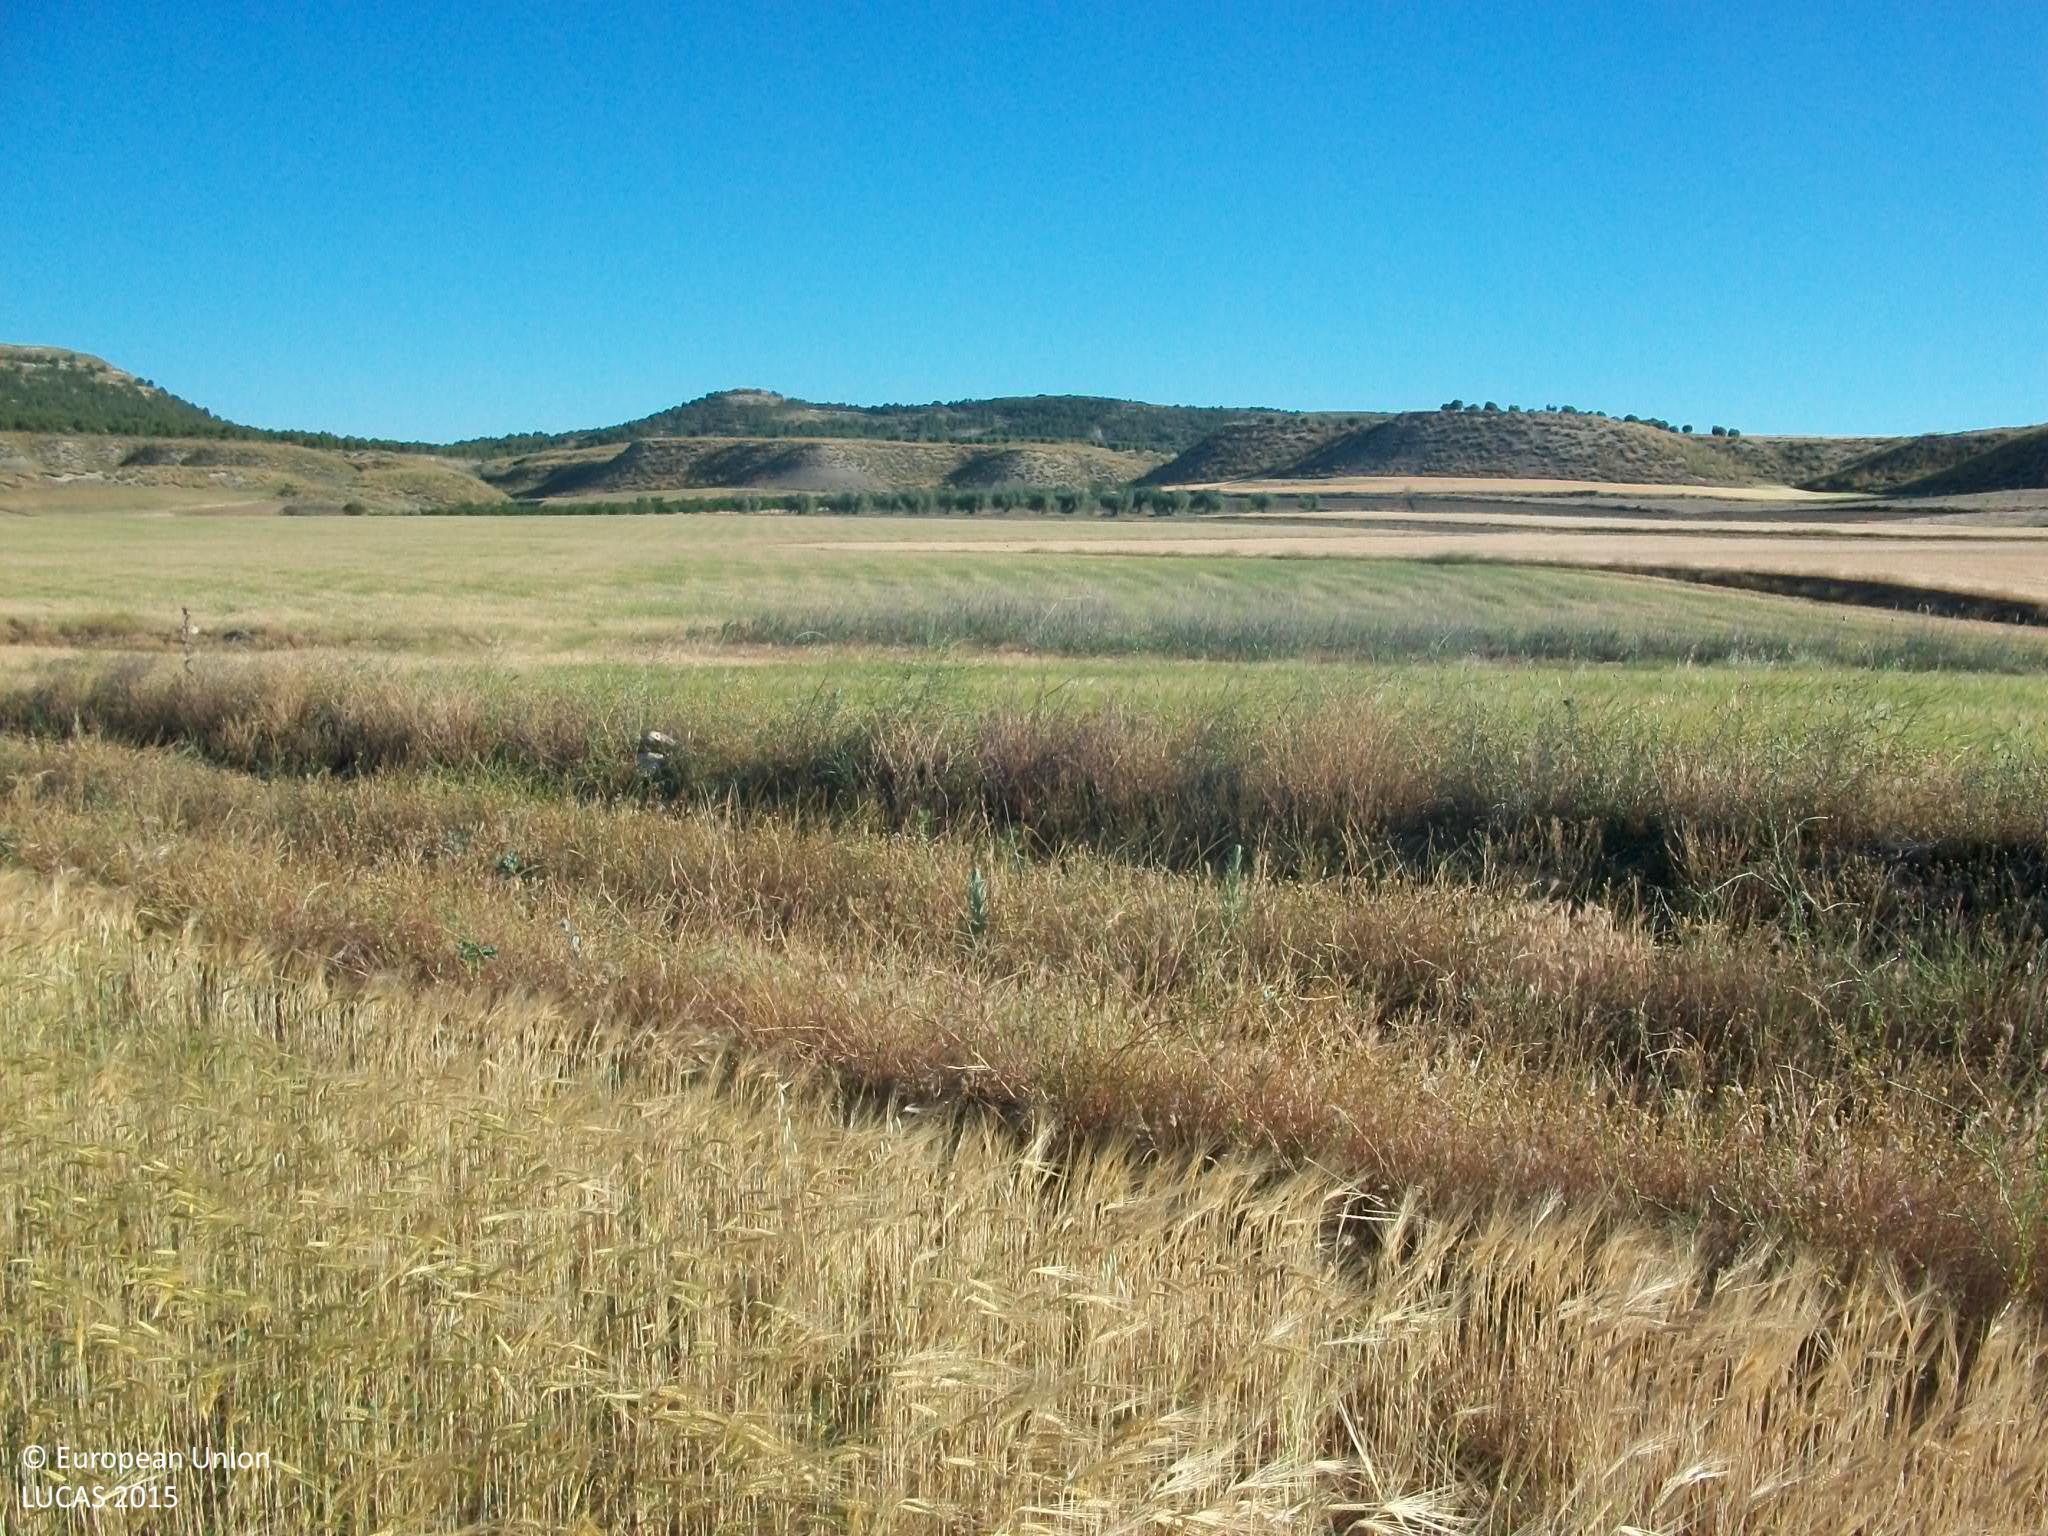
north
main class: Cropland
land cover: Barley
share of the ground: > 75 %
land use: Agriculture (excluding fallow land and kitchen gardens)
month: May
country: ES
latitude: 39.9020
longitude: -3.7277
